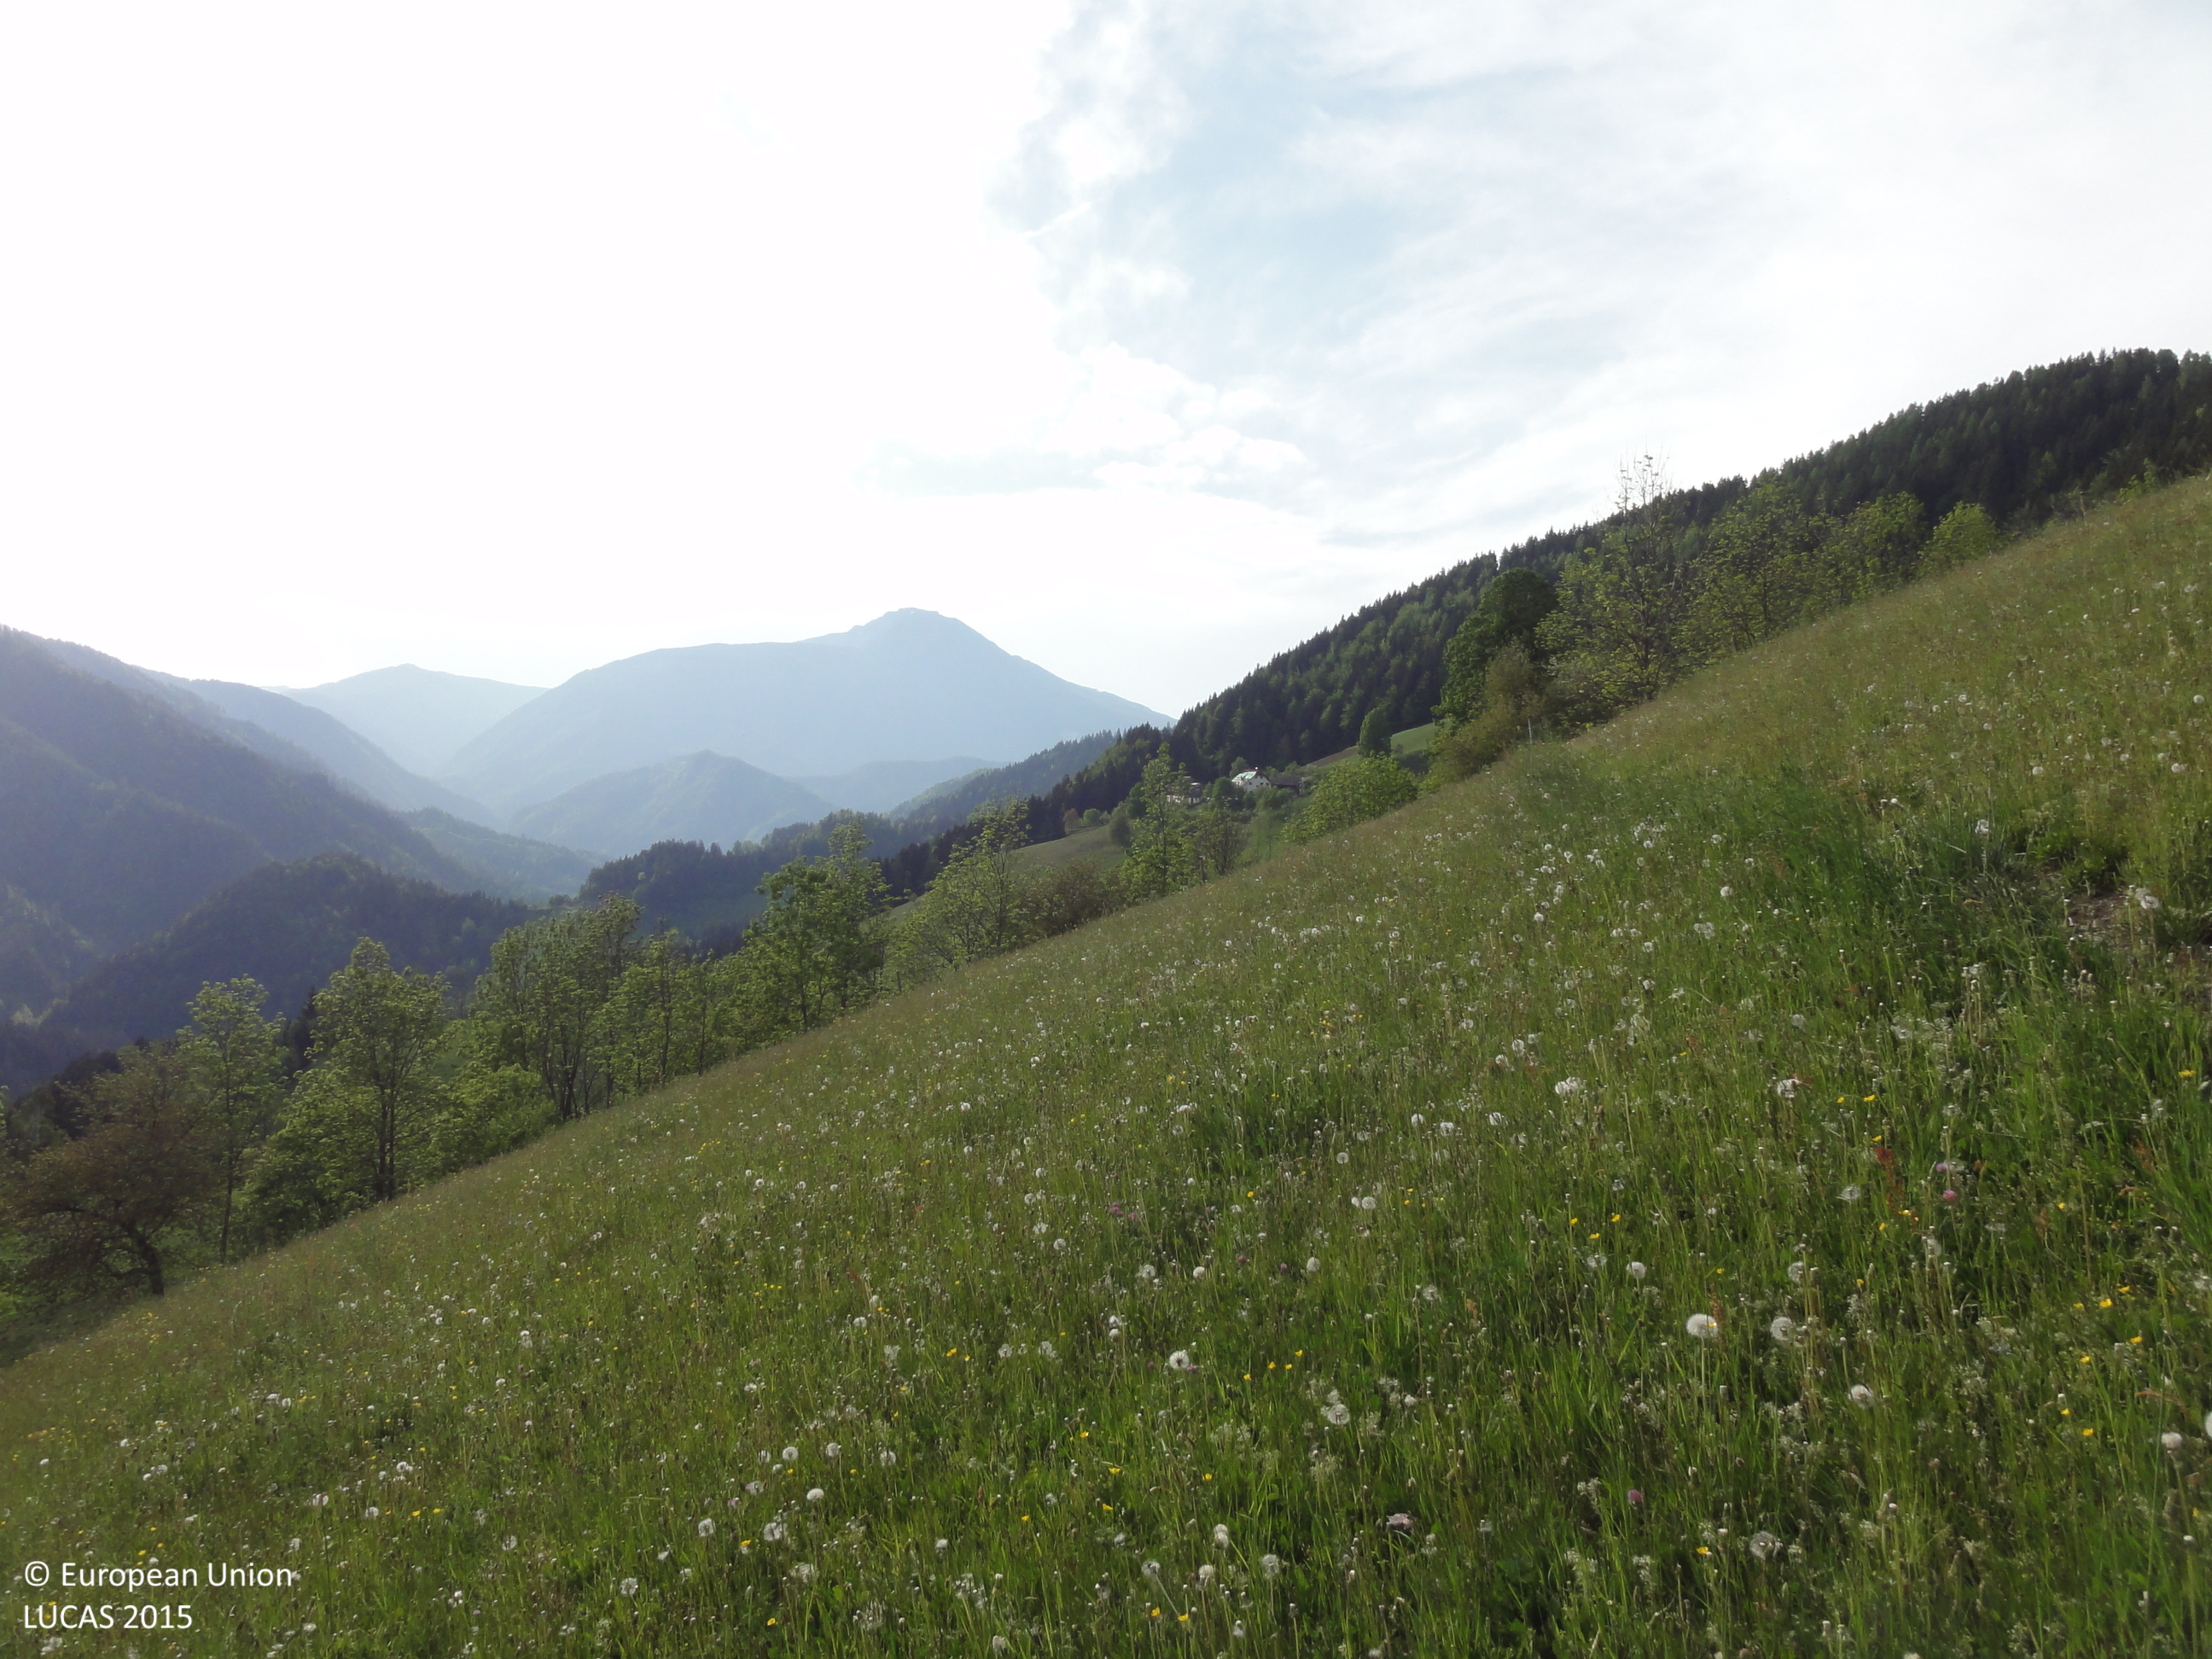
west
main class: Grassland
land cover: Grassland without tree/shrub cover
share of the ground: > 75 %
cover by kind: herbaceous plants 100 %
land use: Agriculture (excluding fallow land and kitchen gardens)
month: May
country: SI
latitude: 46.4552
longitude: 14.9061
